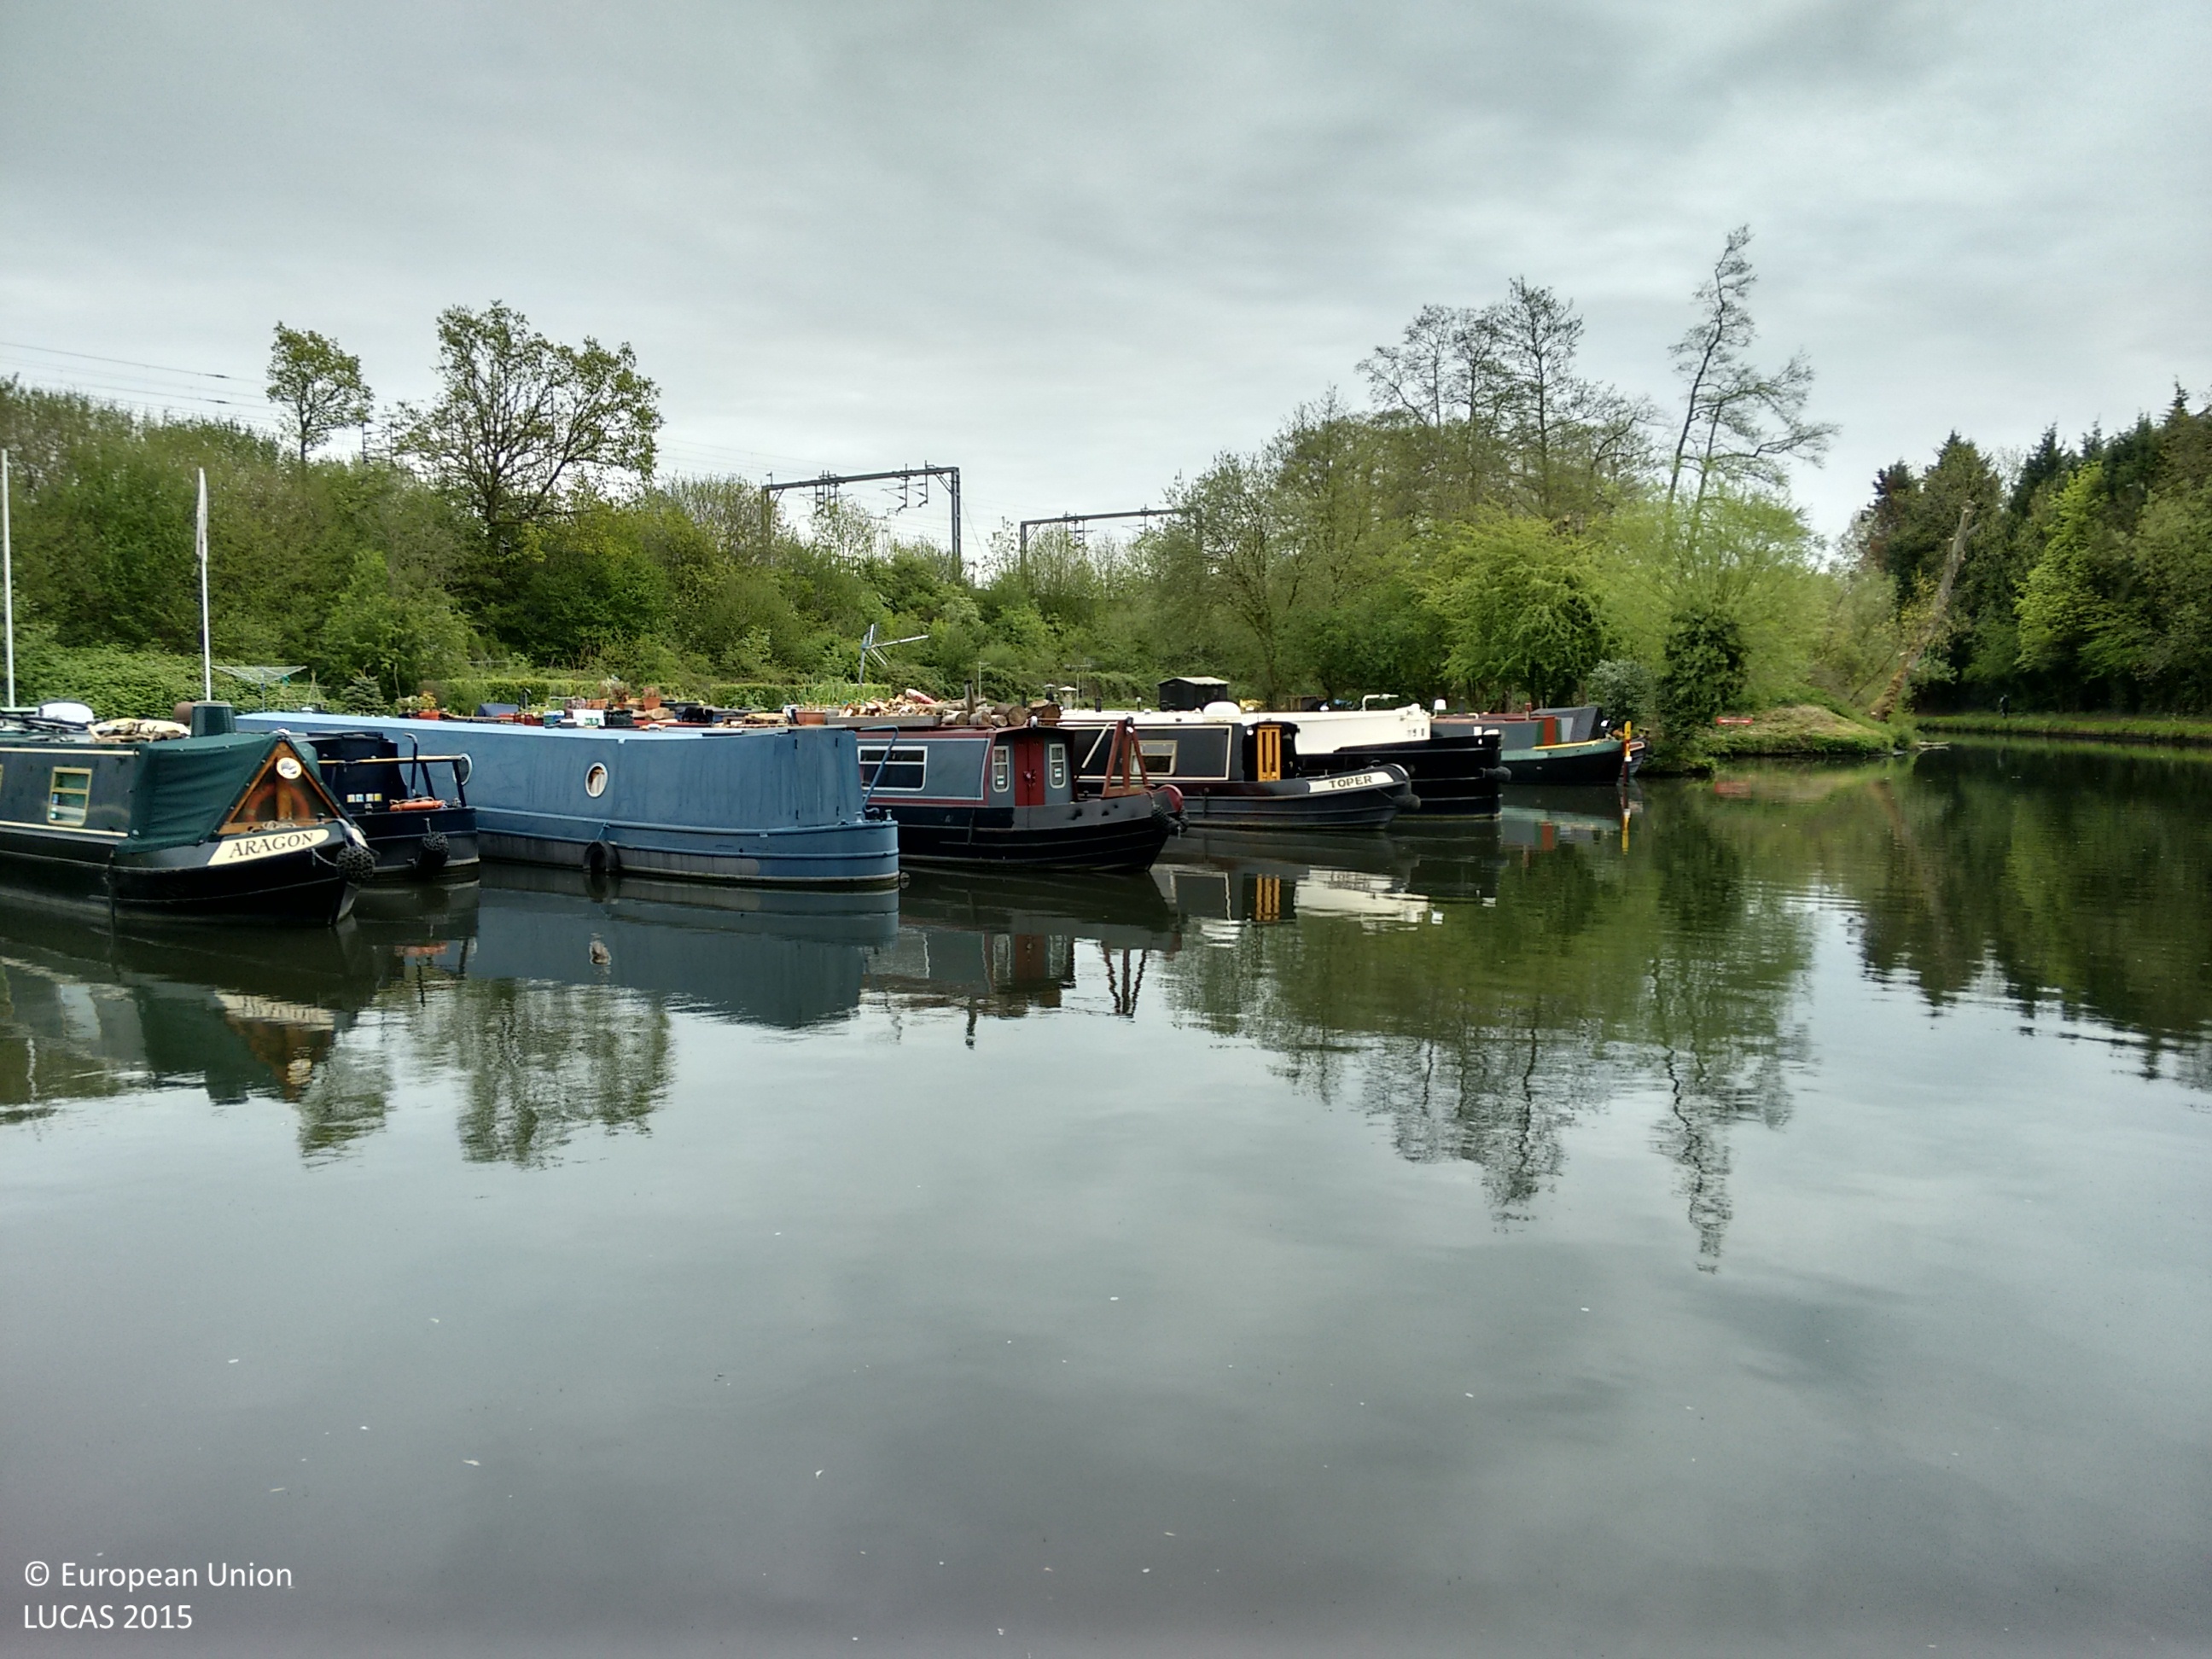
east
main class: Grassland
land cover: Grassland without tree/shrub cover
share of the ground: > 75 %
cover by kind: herbaceous plants 100 %
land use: Amenities, museums, leisure
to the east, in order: Grassland without tree/shrub cover; Broadleaved woodland; Railways; Electric lines; Broadleaved woodland; Grassland without tree/shrub cover
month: May
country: GB
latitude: 51.7463
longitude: -0.5103
